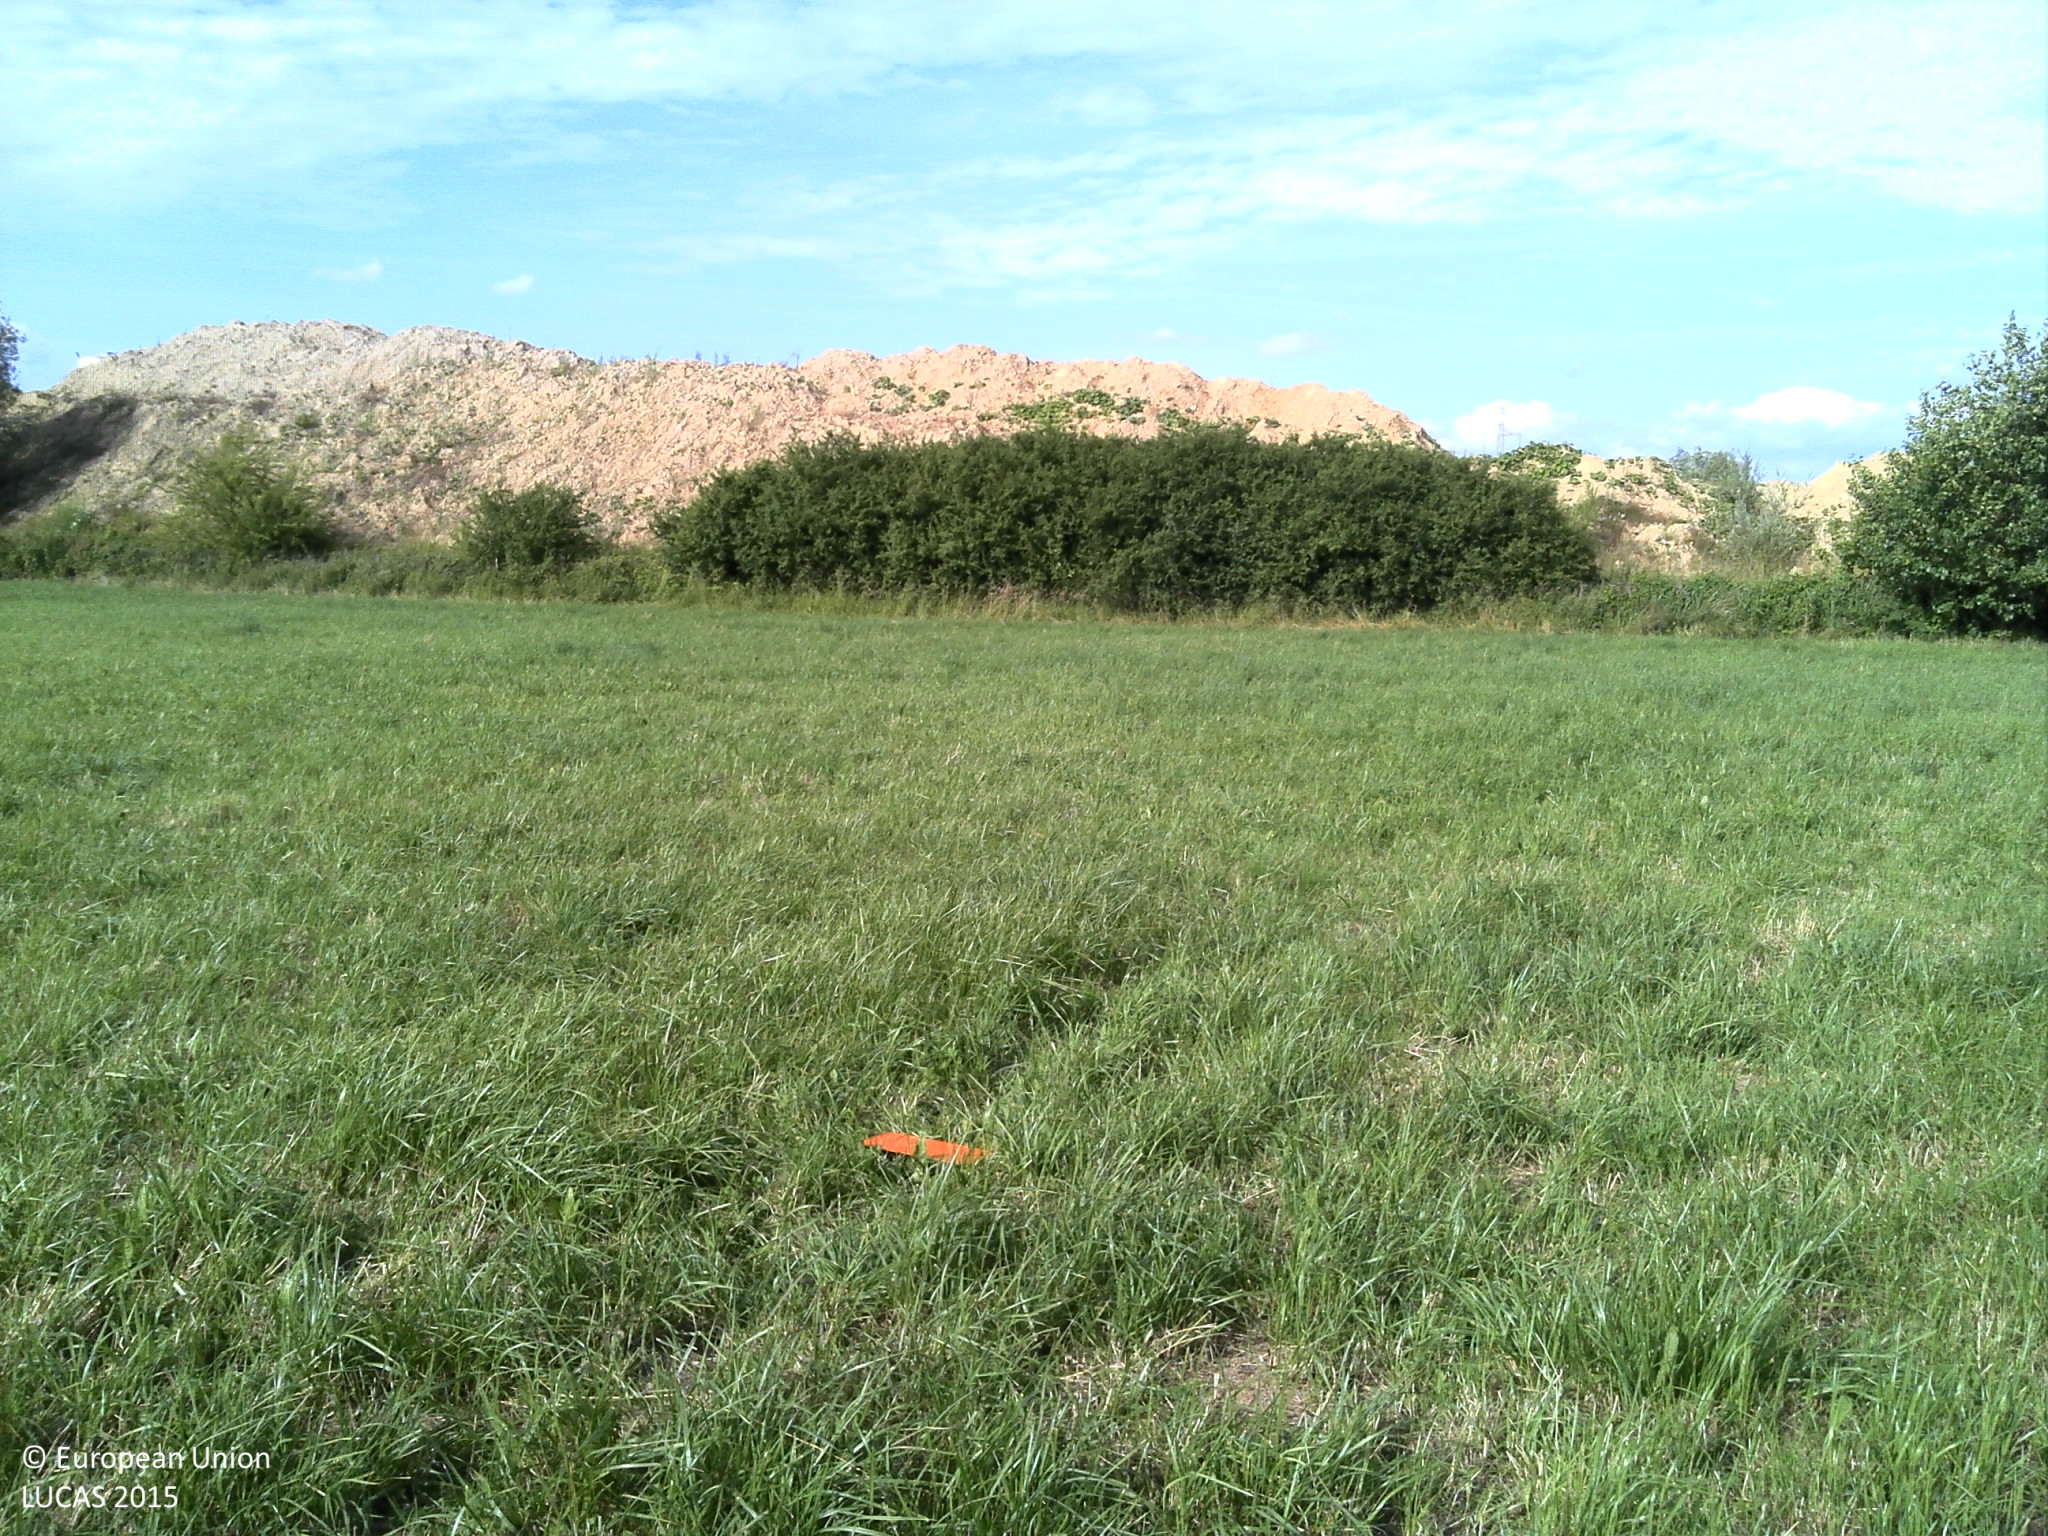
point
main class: Grassland
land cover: Grassland without tree/shrub cover
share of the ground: > 75 %
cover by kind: herbaceous plants 100 %
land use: Agriculture (excluding fallow land and kitchen gardens)
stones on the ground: < 10 %
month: June
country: FR
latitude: 49.7218
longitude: 4.7675
